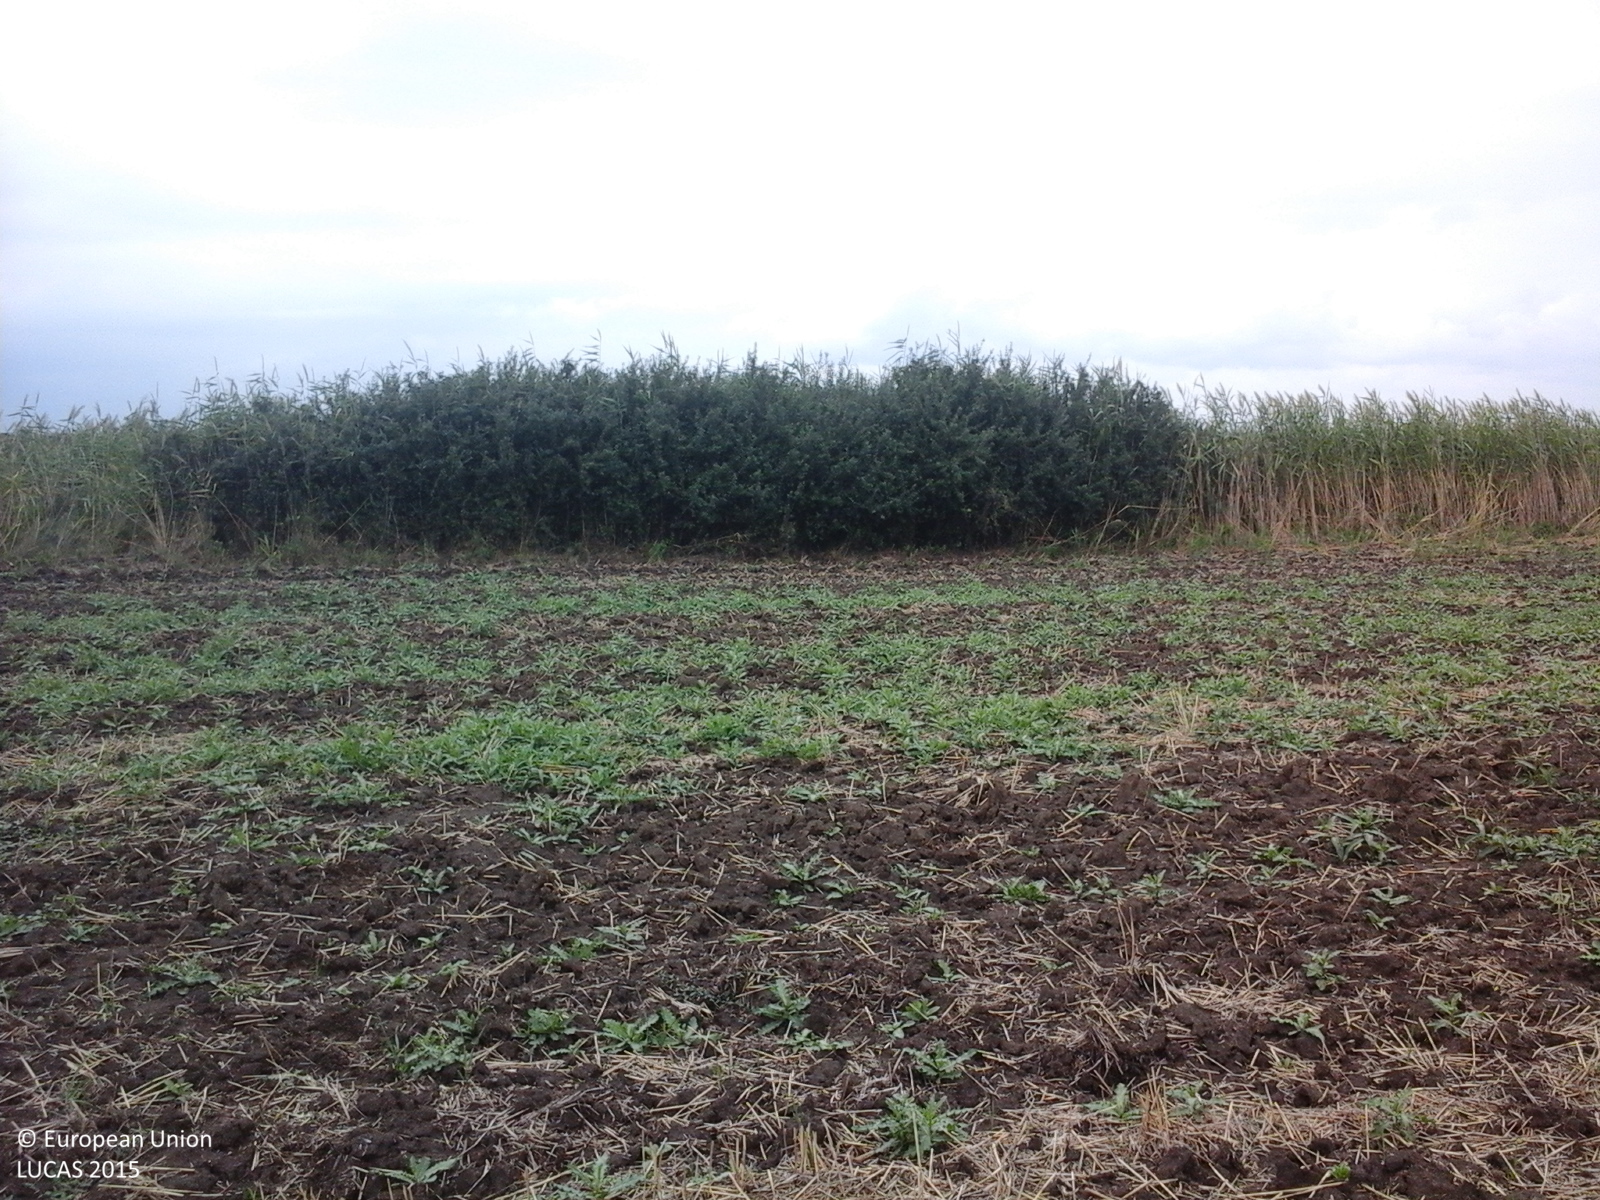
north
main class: Cropland
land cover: Common wheat
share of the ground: < 10 %
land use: Agriculture (excluding fallow land and kitchen gardens)
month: August
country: RO
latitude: 46.0630
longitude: 20.5606
